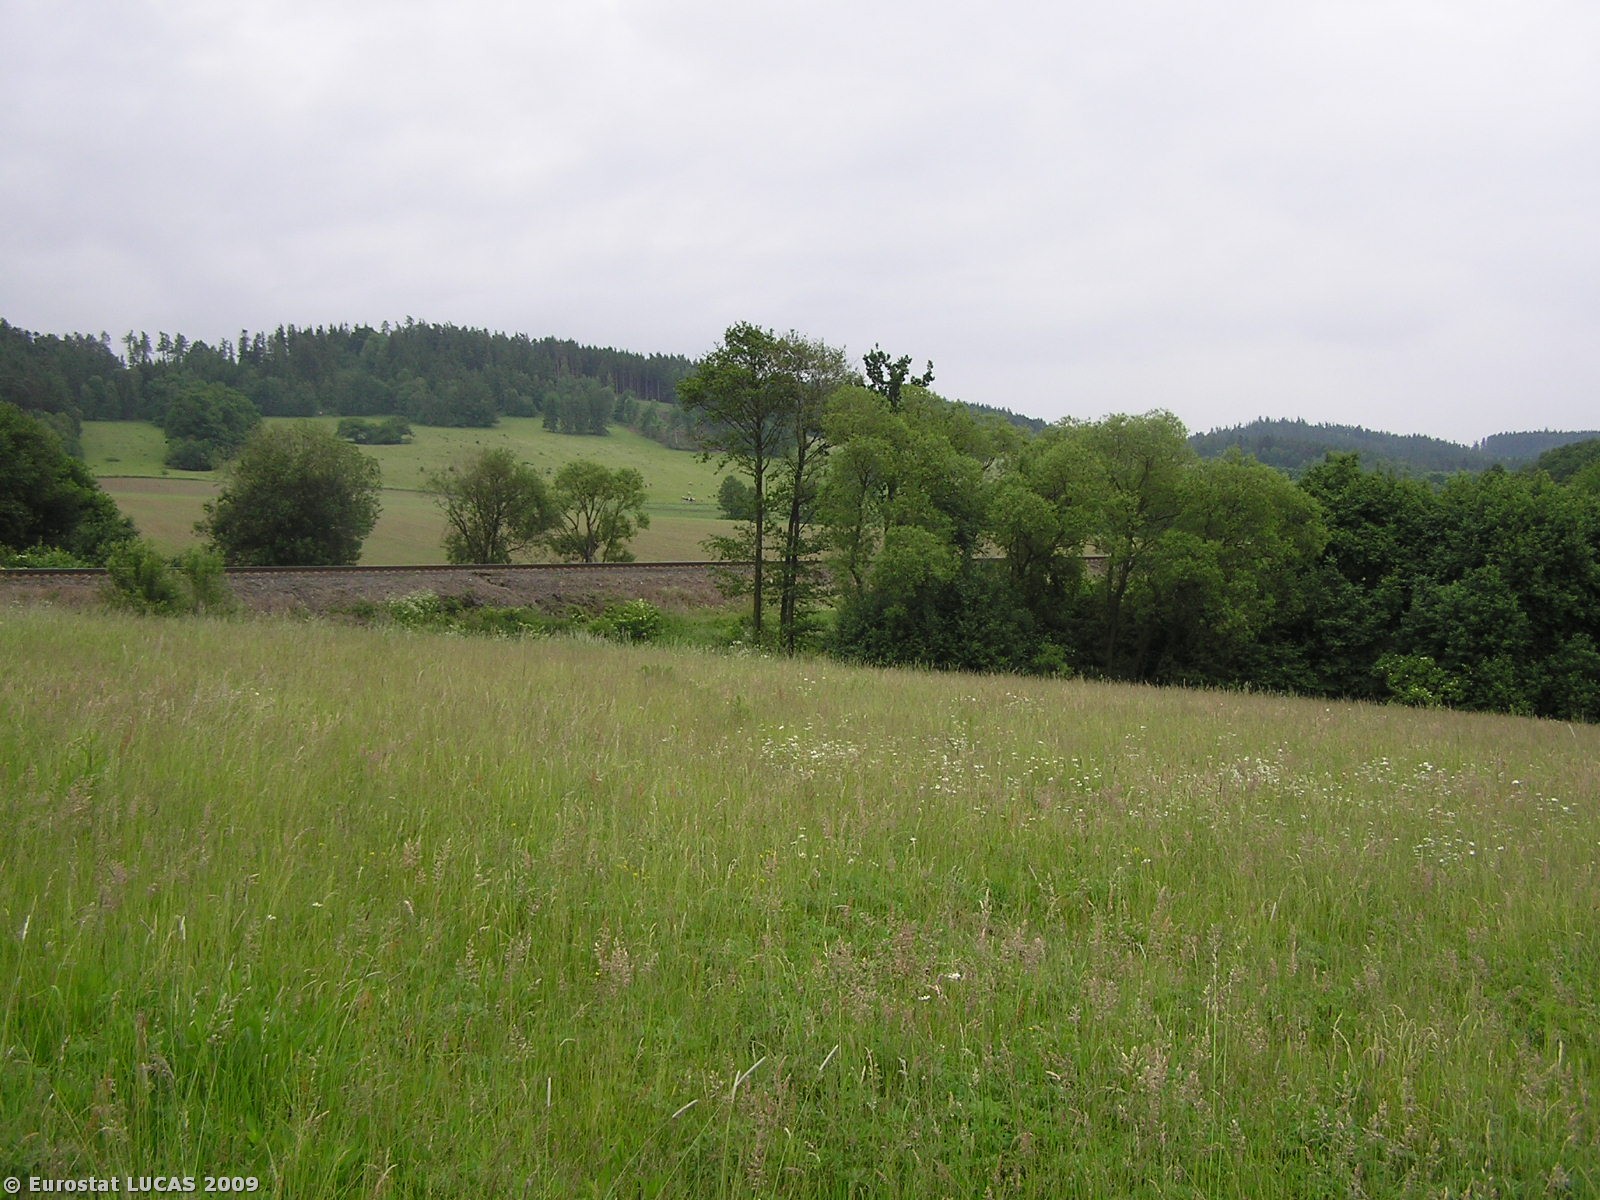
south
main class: Grassland
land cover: Grassland without tree/shrub cover
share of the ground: > 75 %
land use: Agriculture (excluding fallow land and kitchen gardens)
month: June
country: CZ
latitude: 50.0551
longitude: 17.6253
